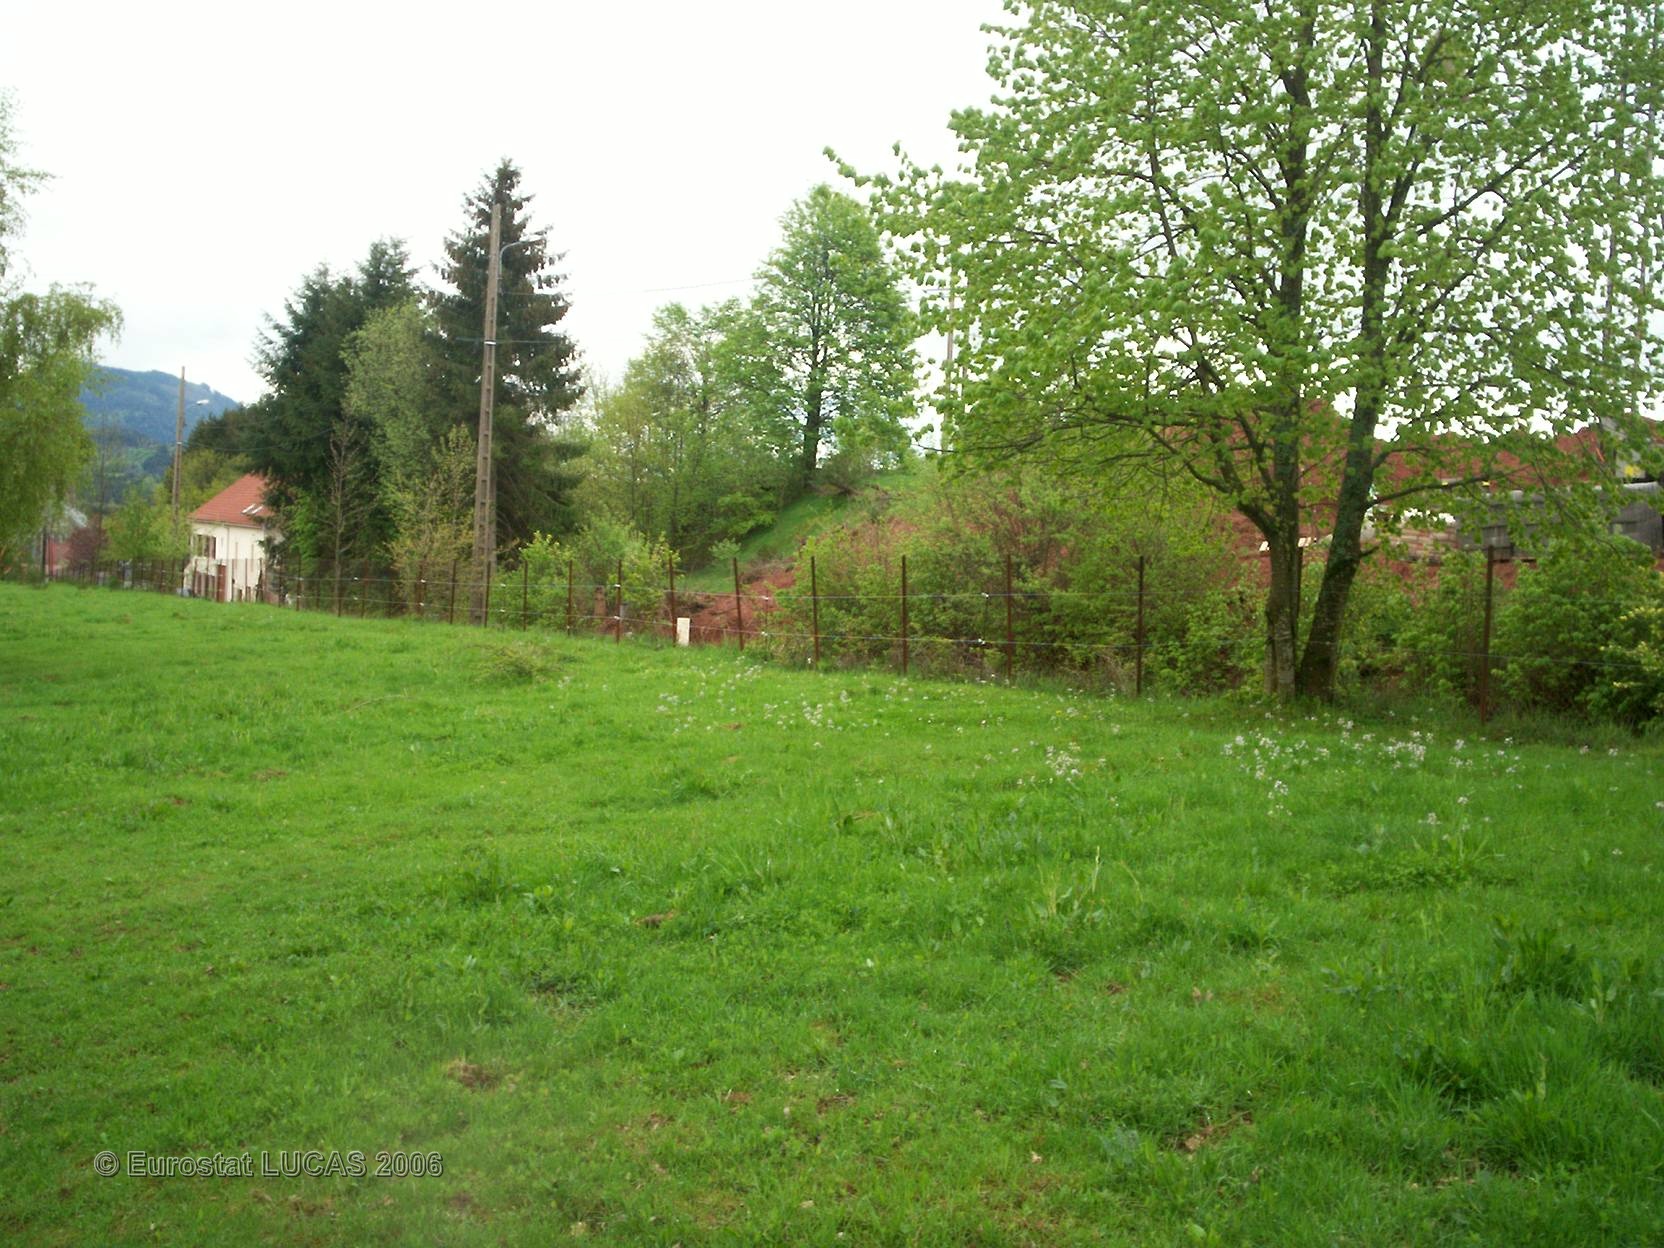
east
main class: Grassland
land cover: Grassland with sparse tree/shrub cover
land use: Amenities, museums, leisure
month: May
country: FR
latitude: 48.3475
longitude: 7.0998
